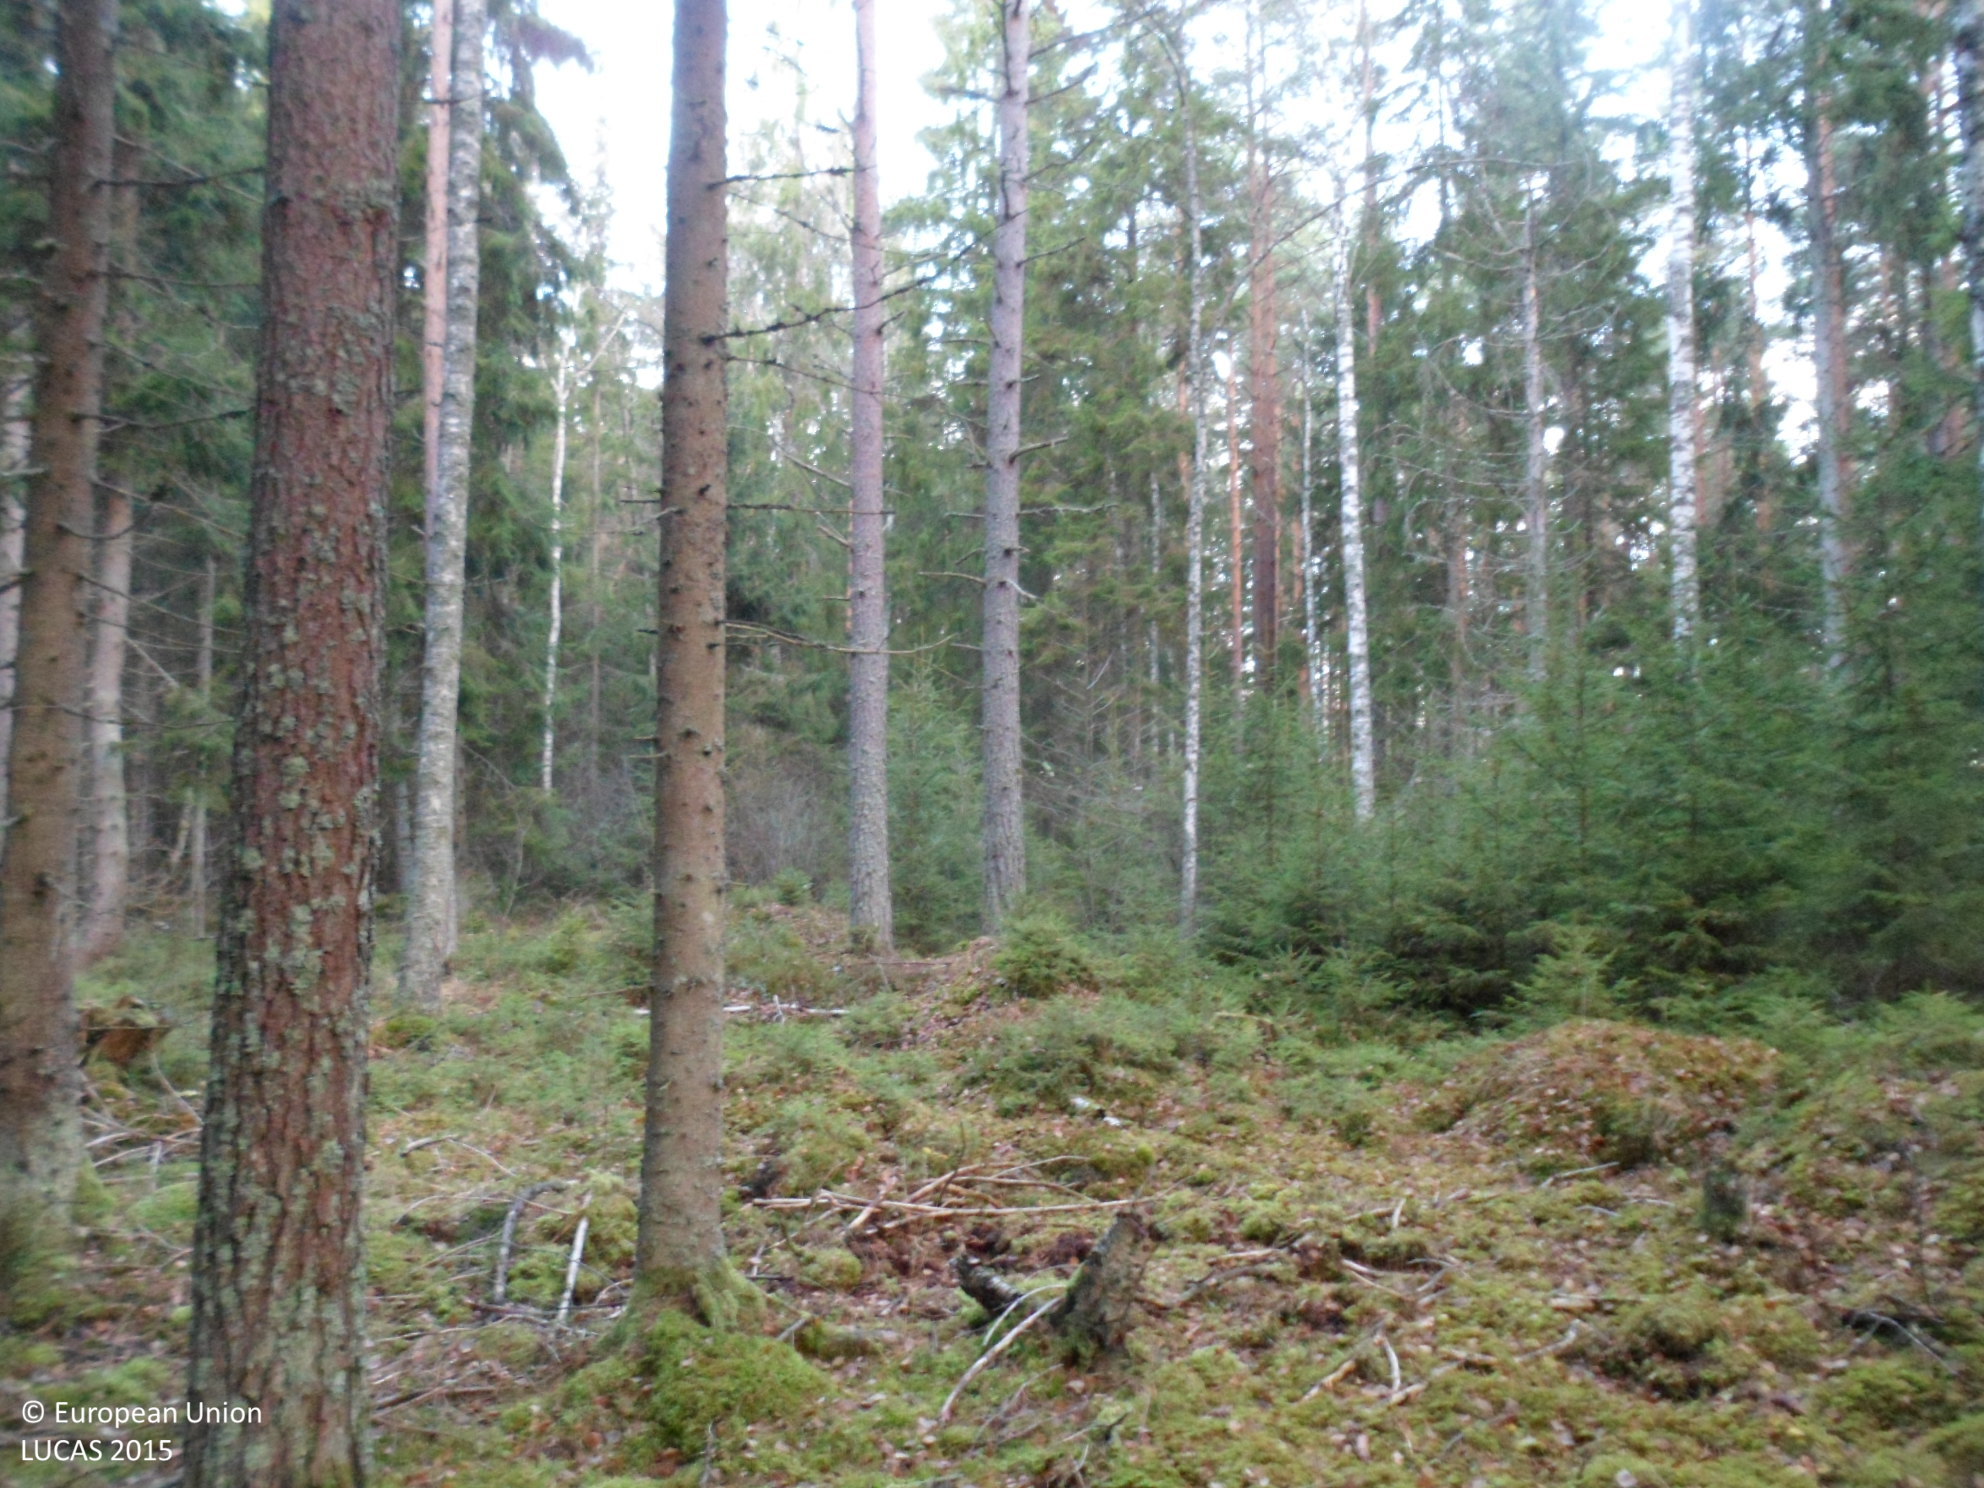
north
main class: Woodland
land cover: Spruce dominated coniferous woodland
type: boreal forest
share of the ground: 50 - 75 %
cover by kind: coniferous forest trees 60 %, lichens and mosses 25 %, shrubs 10 %, unconsolidated bare surface 5 %
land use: Forestry
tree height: > 5 m
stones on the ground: < 10 %
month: November
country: SE
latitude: 56.7507
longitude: 16.0014
